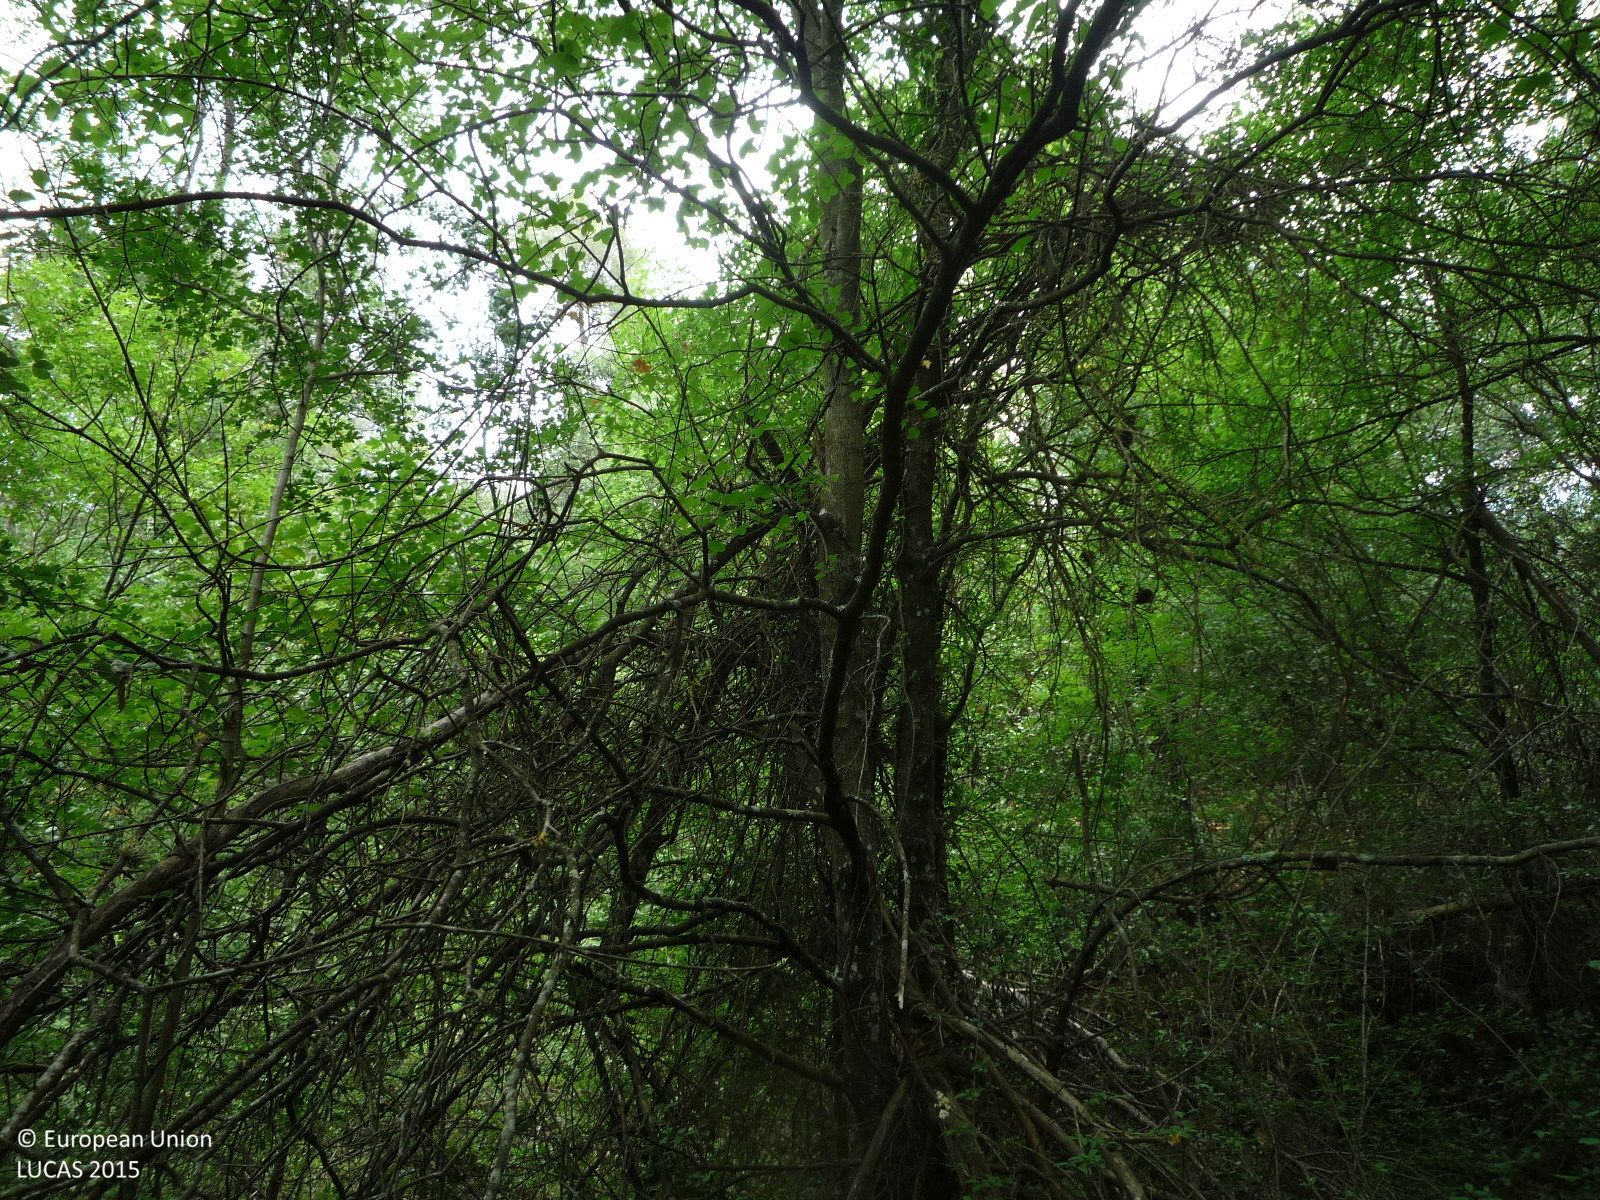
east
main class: Woodland
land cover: Pine dominated mixed woodland
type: coniferous forest of the mediterranean region
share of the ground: > 75 %
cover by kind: coniferous forest trees 60 %, broadleaved forest trees 40 %
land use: Forestry
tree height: > 5 m
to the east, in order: Pine dominated mixed woodland; Tracks; Pine dominated mixed woodland; Tracks; Pine dominated mixed woodland; Dry stone walls; Pine dominated mixed woodland; Fences; Pine dominated mixed woodland; Dry stone walls; Pine dominated mixed woodland; Dry stone walls; Pine dominated mixed woodland; Dry stone walls; Pine dominated mixed woodland
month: June
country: ES
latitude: 41.8118
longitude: 2.0102
